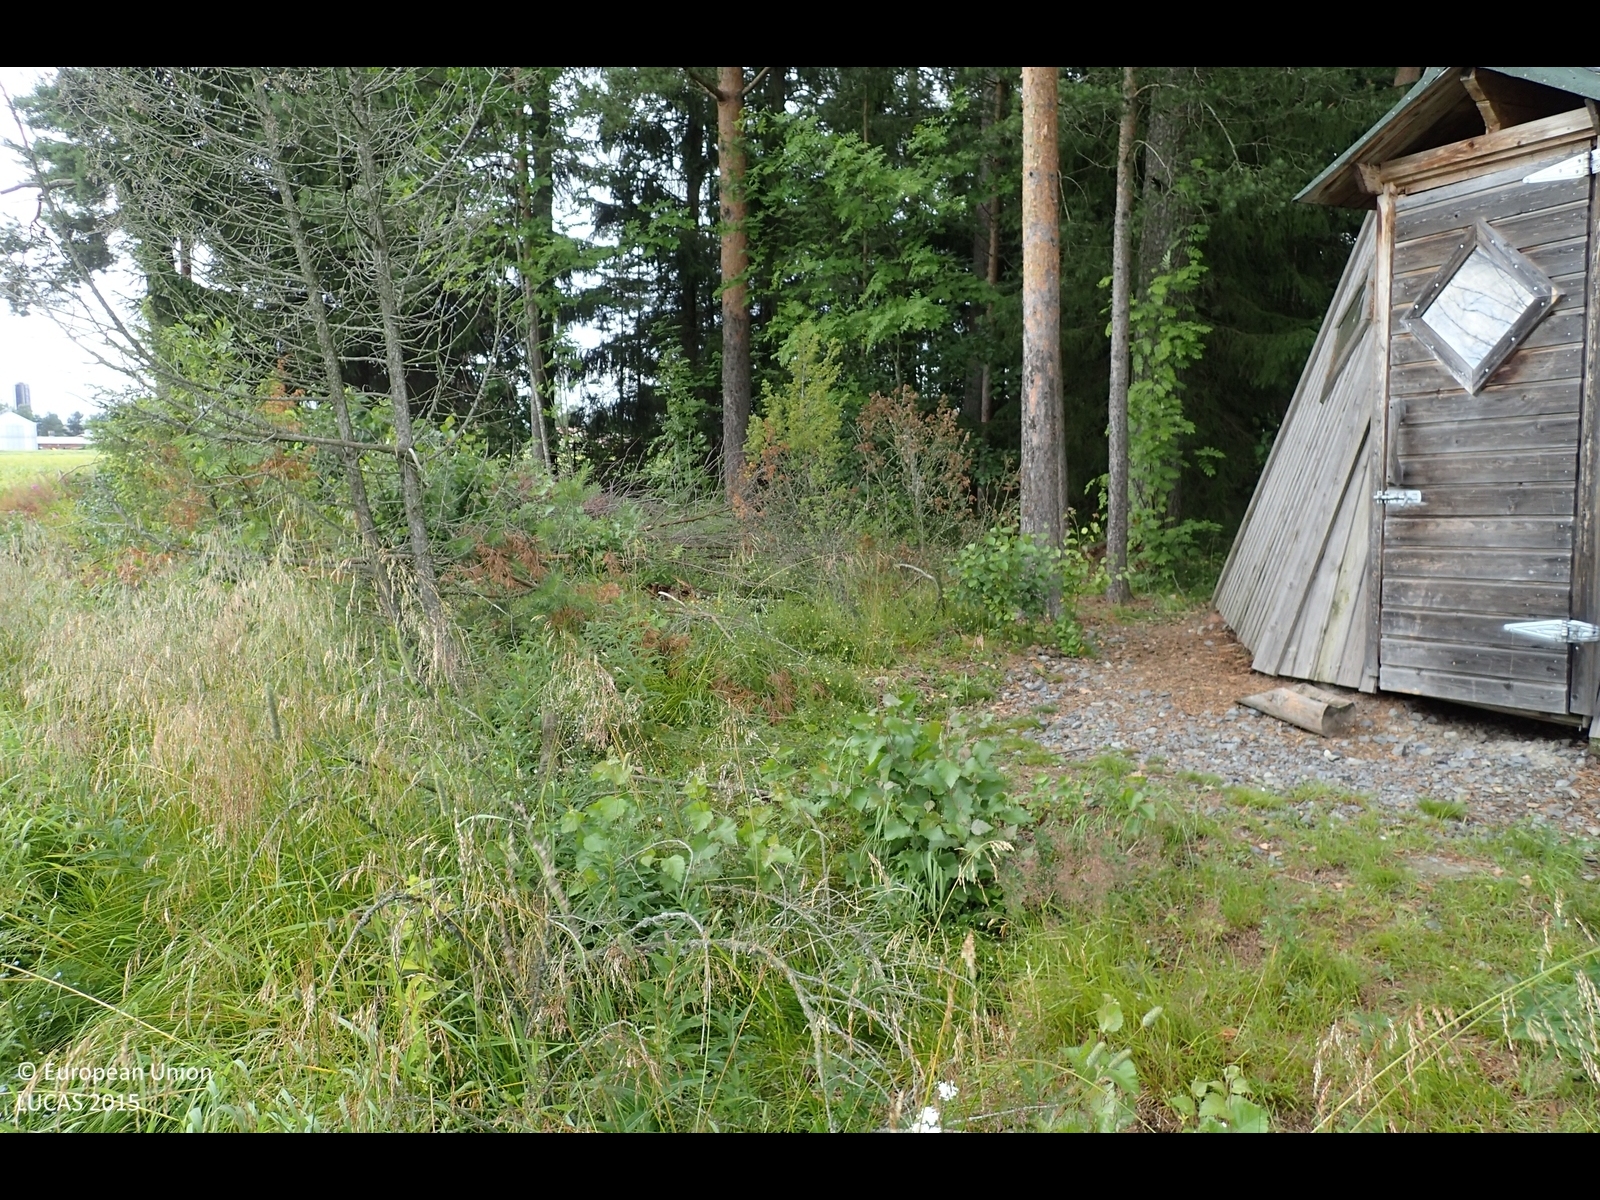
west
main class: Cropland
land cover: Barley
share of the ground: > 75 %
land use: Agriculture (excluding fallow land and kitchen gardens)
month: July
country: FI
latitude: 62.7959
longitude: 22.5833
